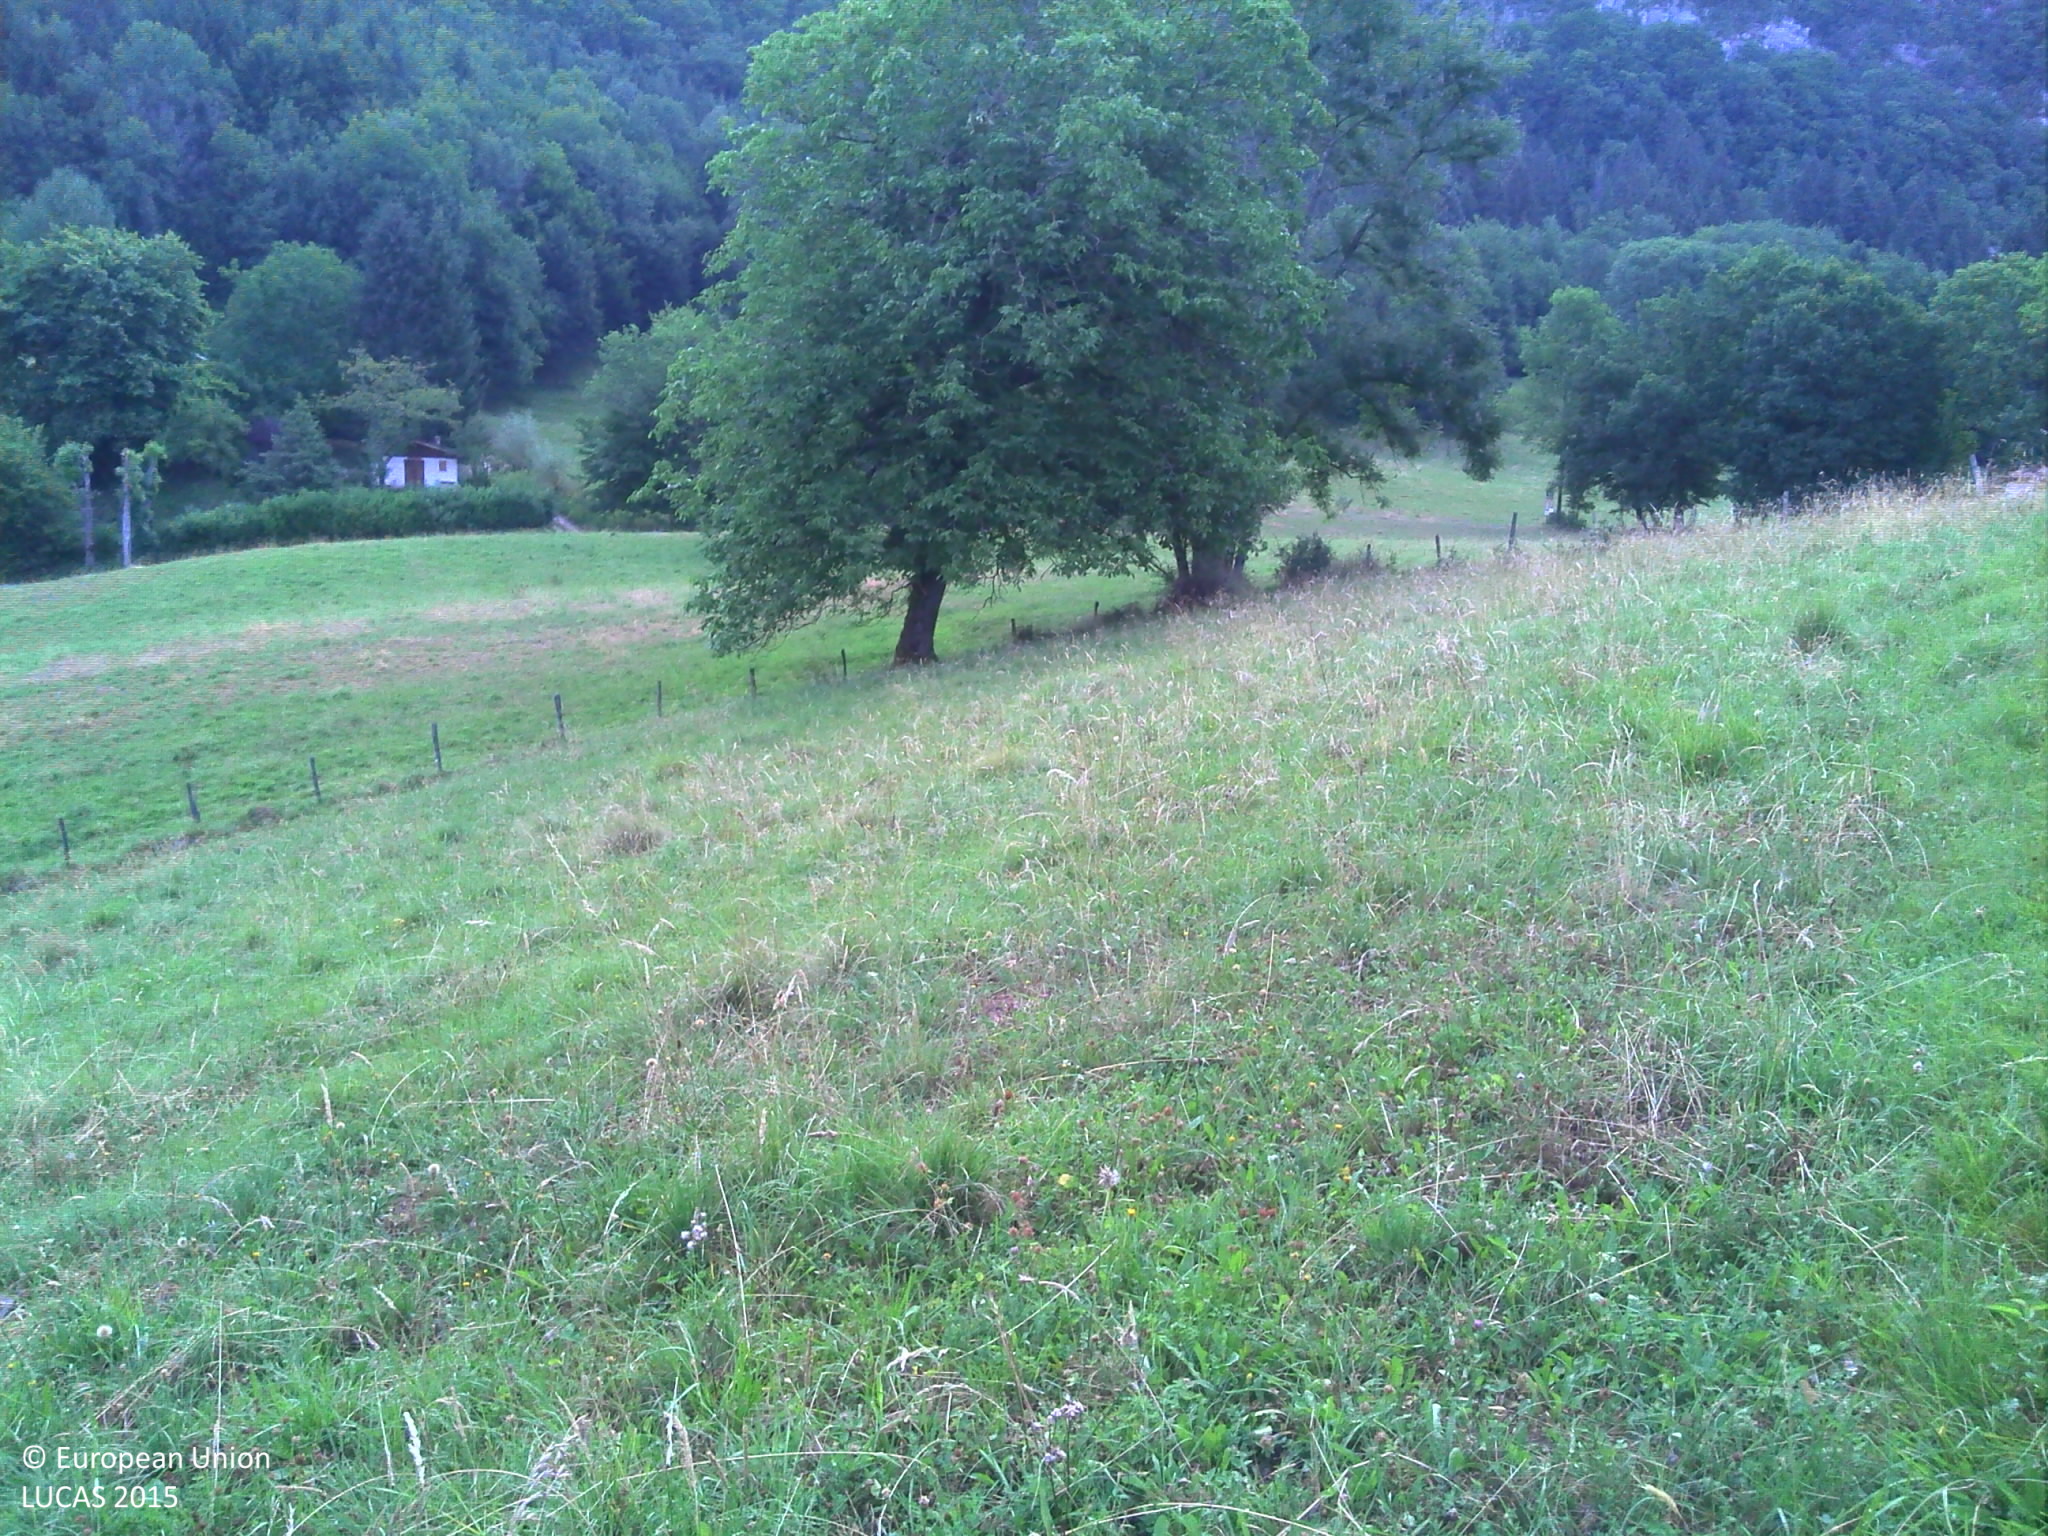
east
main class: Grassland
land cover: Grassland without tree/shrub cover
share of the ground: > 75 %
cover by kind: herbaceous plants 100 %
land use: Agriculture (excluding fallow land and kitchen gardens)
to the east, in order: Grassland without tree/shrub cover; Fences; Grassland without tree/shrub cover; Fences; Grassland without tree/shrub cover; Fences; Grass margins; Paved roads, cycling and walking lanes; Ditches and canals; Fences; Grassland without tree/shrub cover; Broadleaved woodland
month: July
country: FR
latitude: 45.9231
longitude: 6.2000
